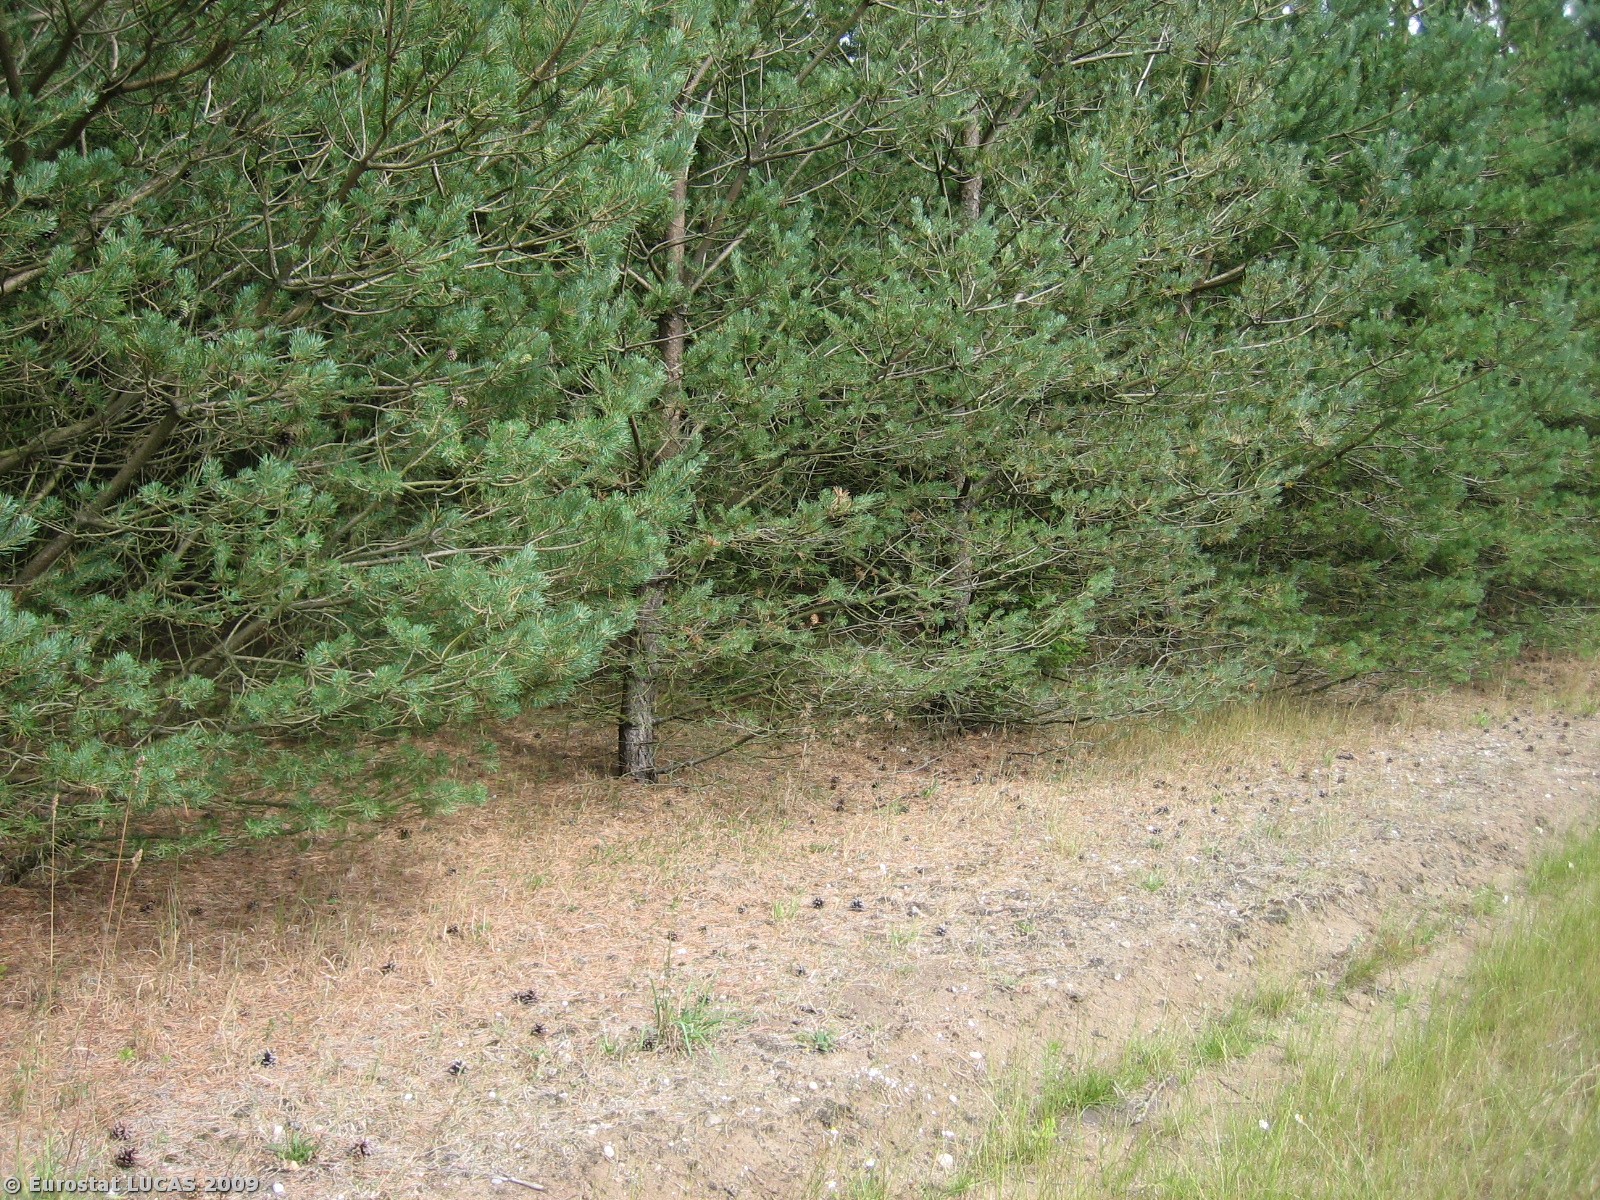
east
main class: Grassland
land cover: Grassland without tree/shrub cover
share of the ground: 50 - 75 %
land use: Forestry
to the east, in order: Grassland without tree/shrub cover; Coniferous woodland; Mixed woodland; Tracks; Grassland with sparse tree/shrub cover; Shrubland with sparse tree cover; Grassland without tree/shrub cover; Tracks; Grassland without tree/shrub cover
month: July
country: DK
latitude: 55.8044
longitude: 8.7728
